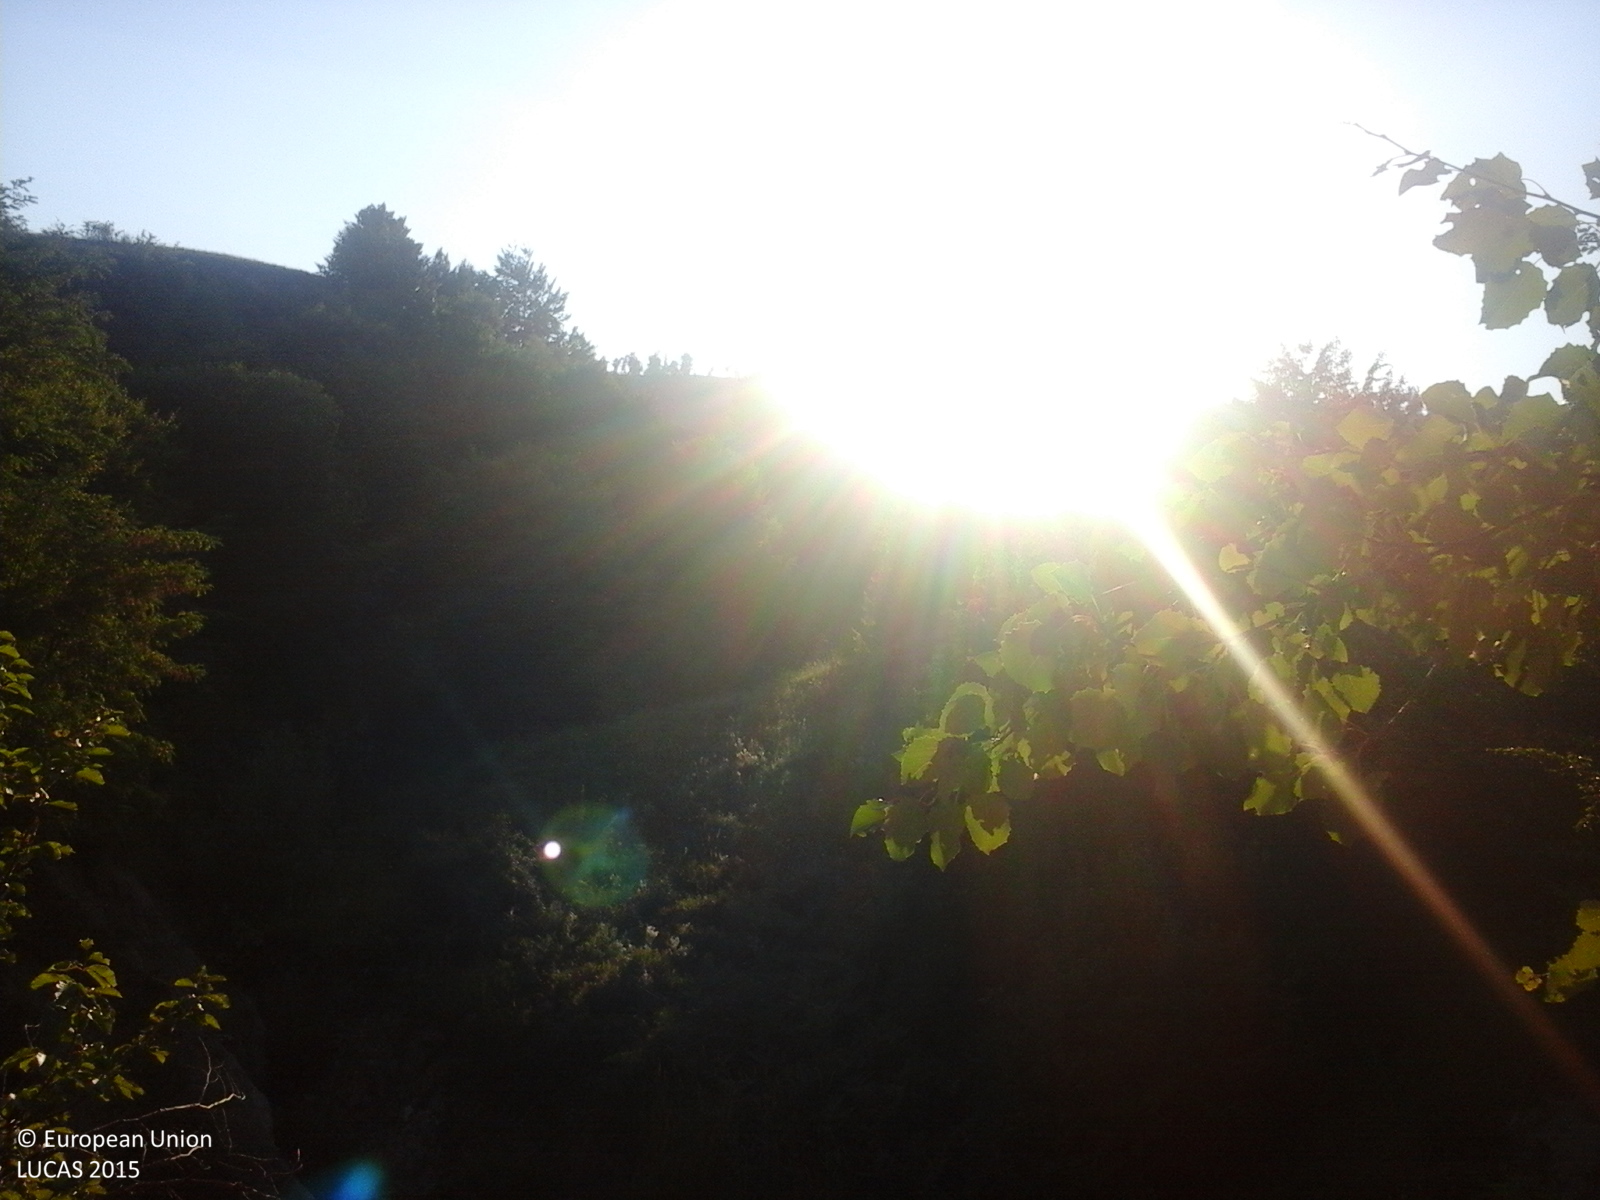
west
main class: Woodland
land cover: Broadleaved woodland
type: beech forest
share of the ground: > 75 %
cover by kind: broadleaved forest trees 100 %
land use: Forestry
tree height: > 5 m
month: August
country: RO
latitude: 46.3068
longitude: 26.8531
